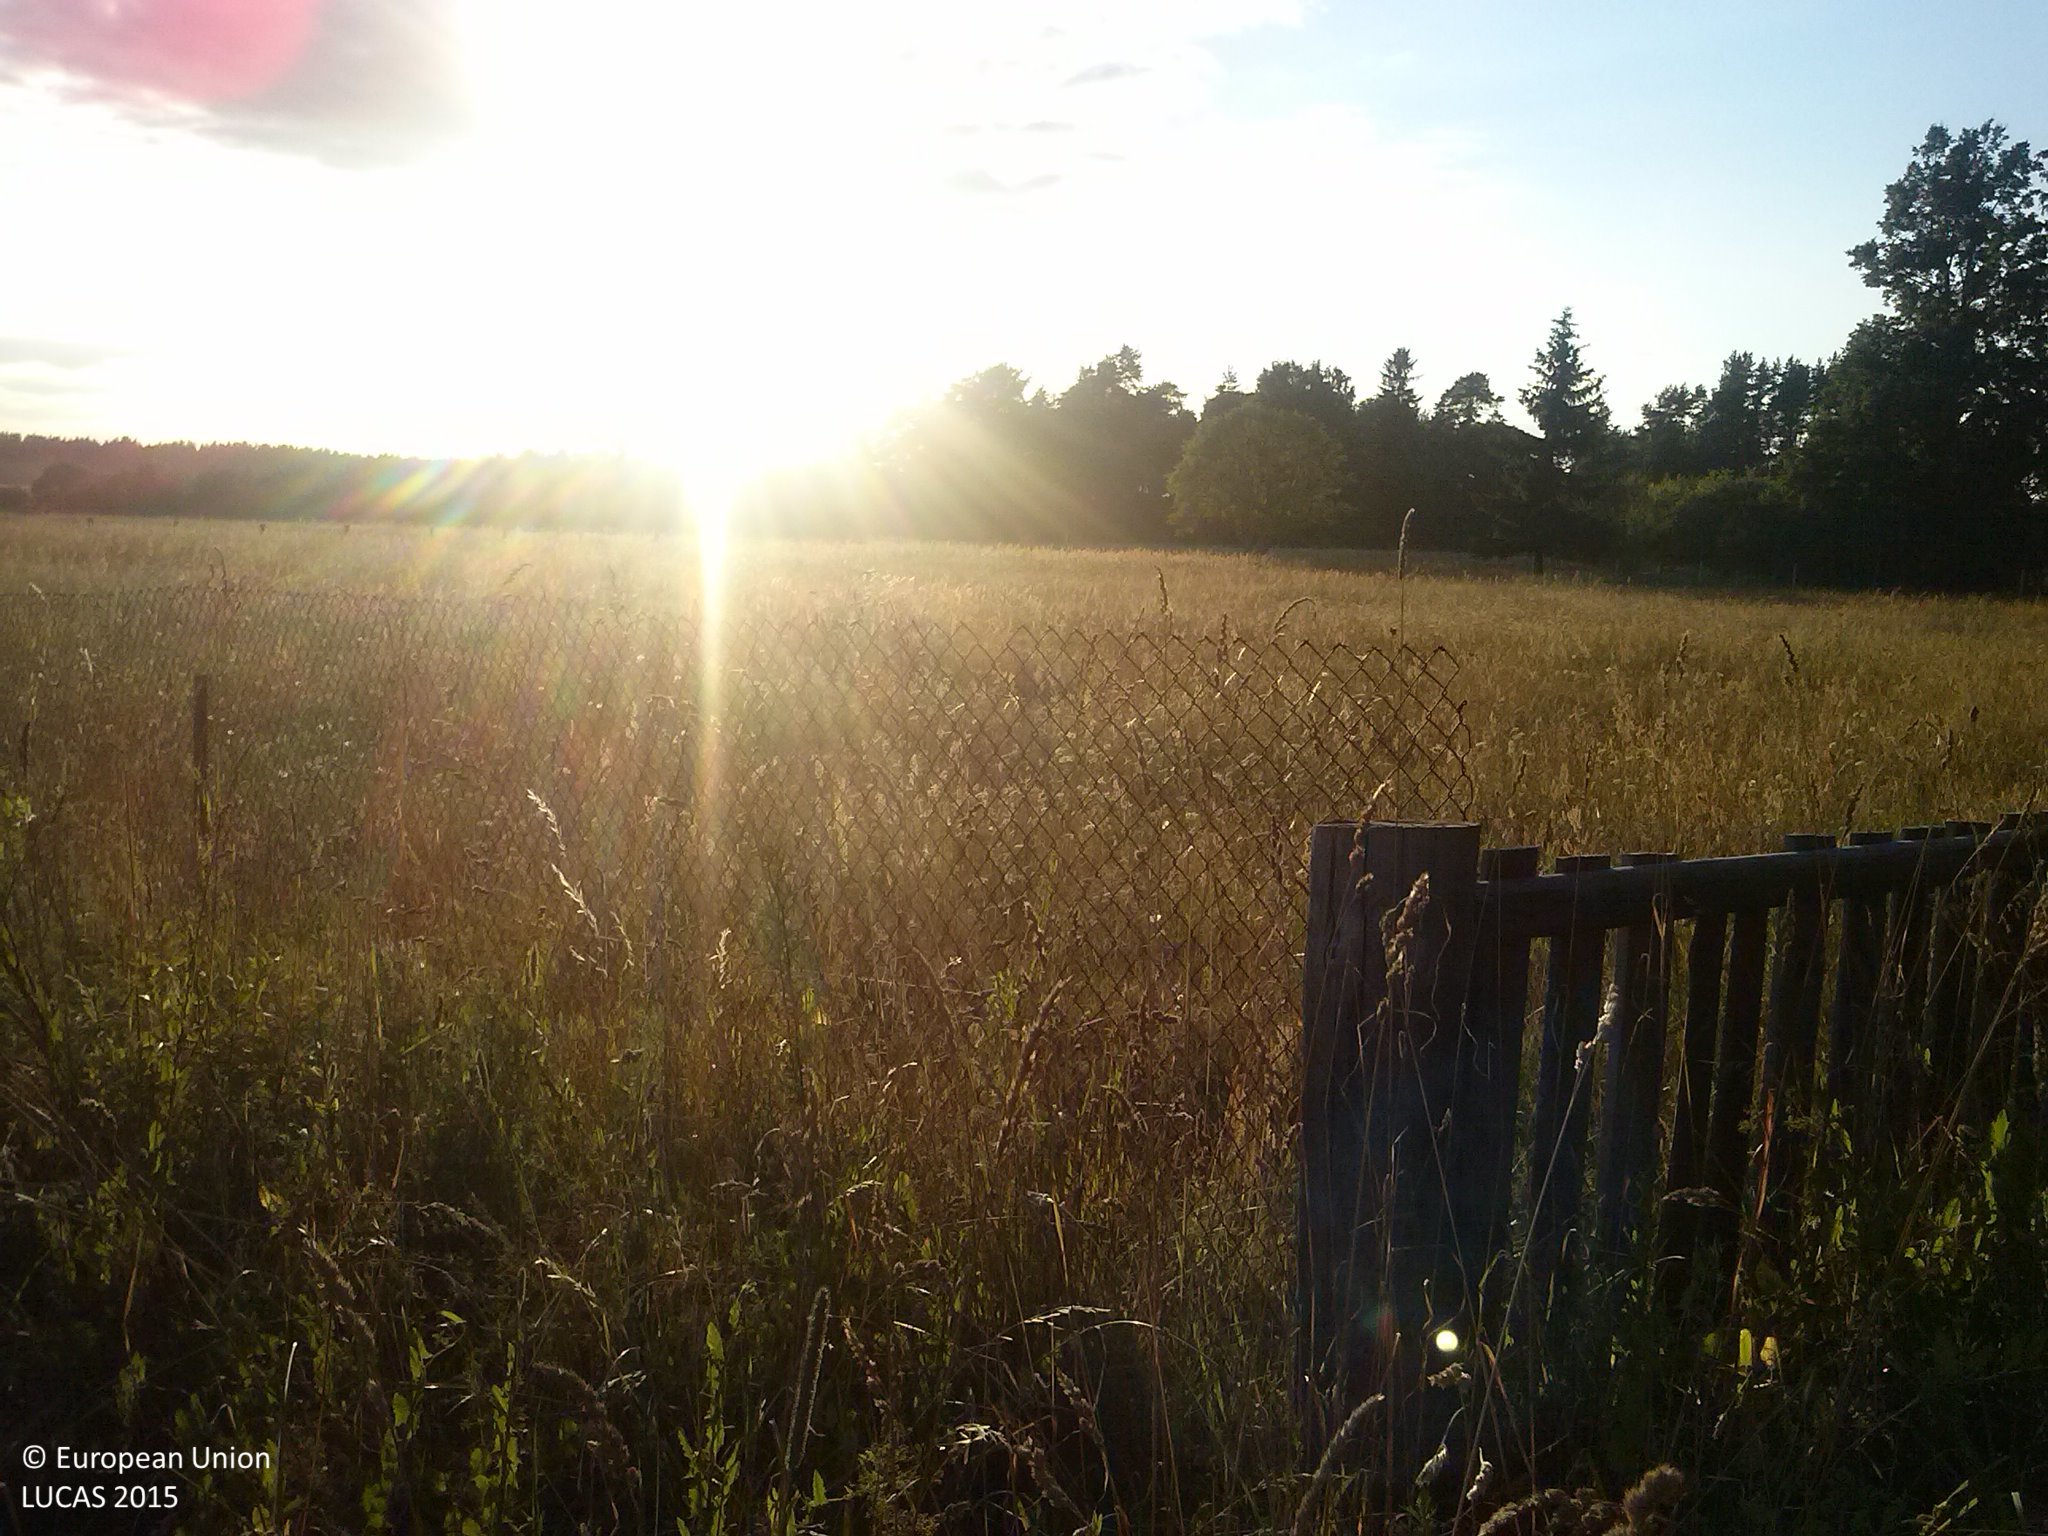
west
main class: Grassland
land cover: Grassland without tree/shrub cover
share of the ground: > 75 %
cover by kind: herbaceous plants 100 %
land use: Agriculture (excluding fallow land and kitchen gardens)
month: July
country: LV
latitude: 56.6168
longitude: 26.9283
